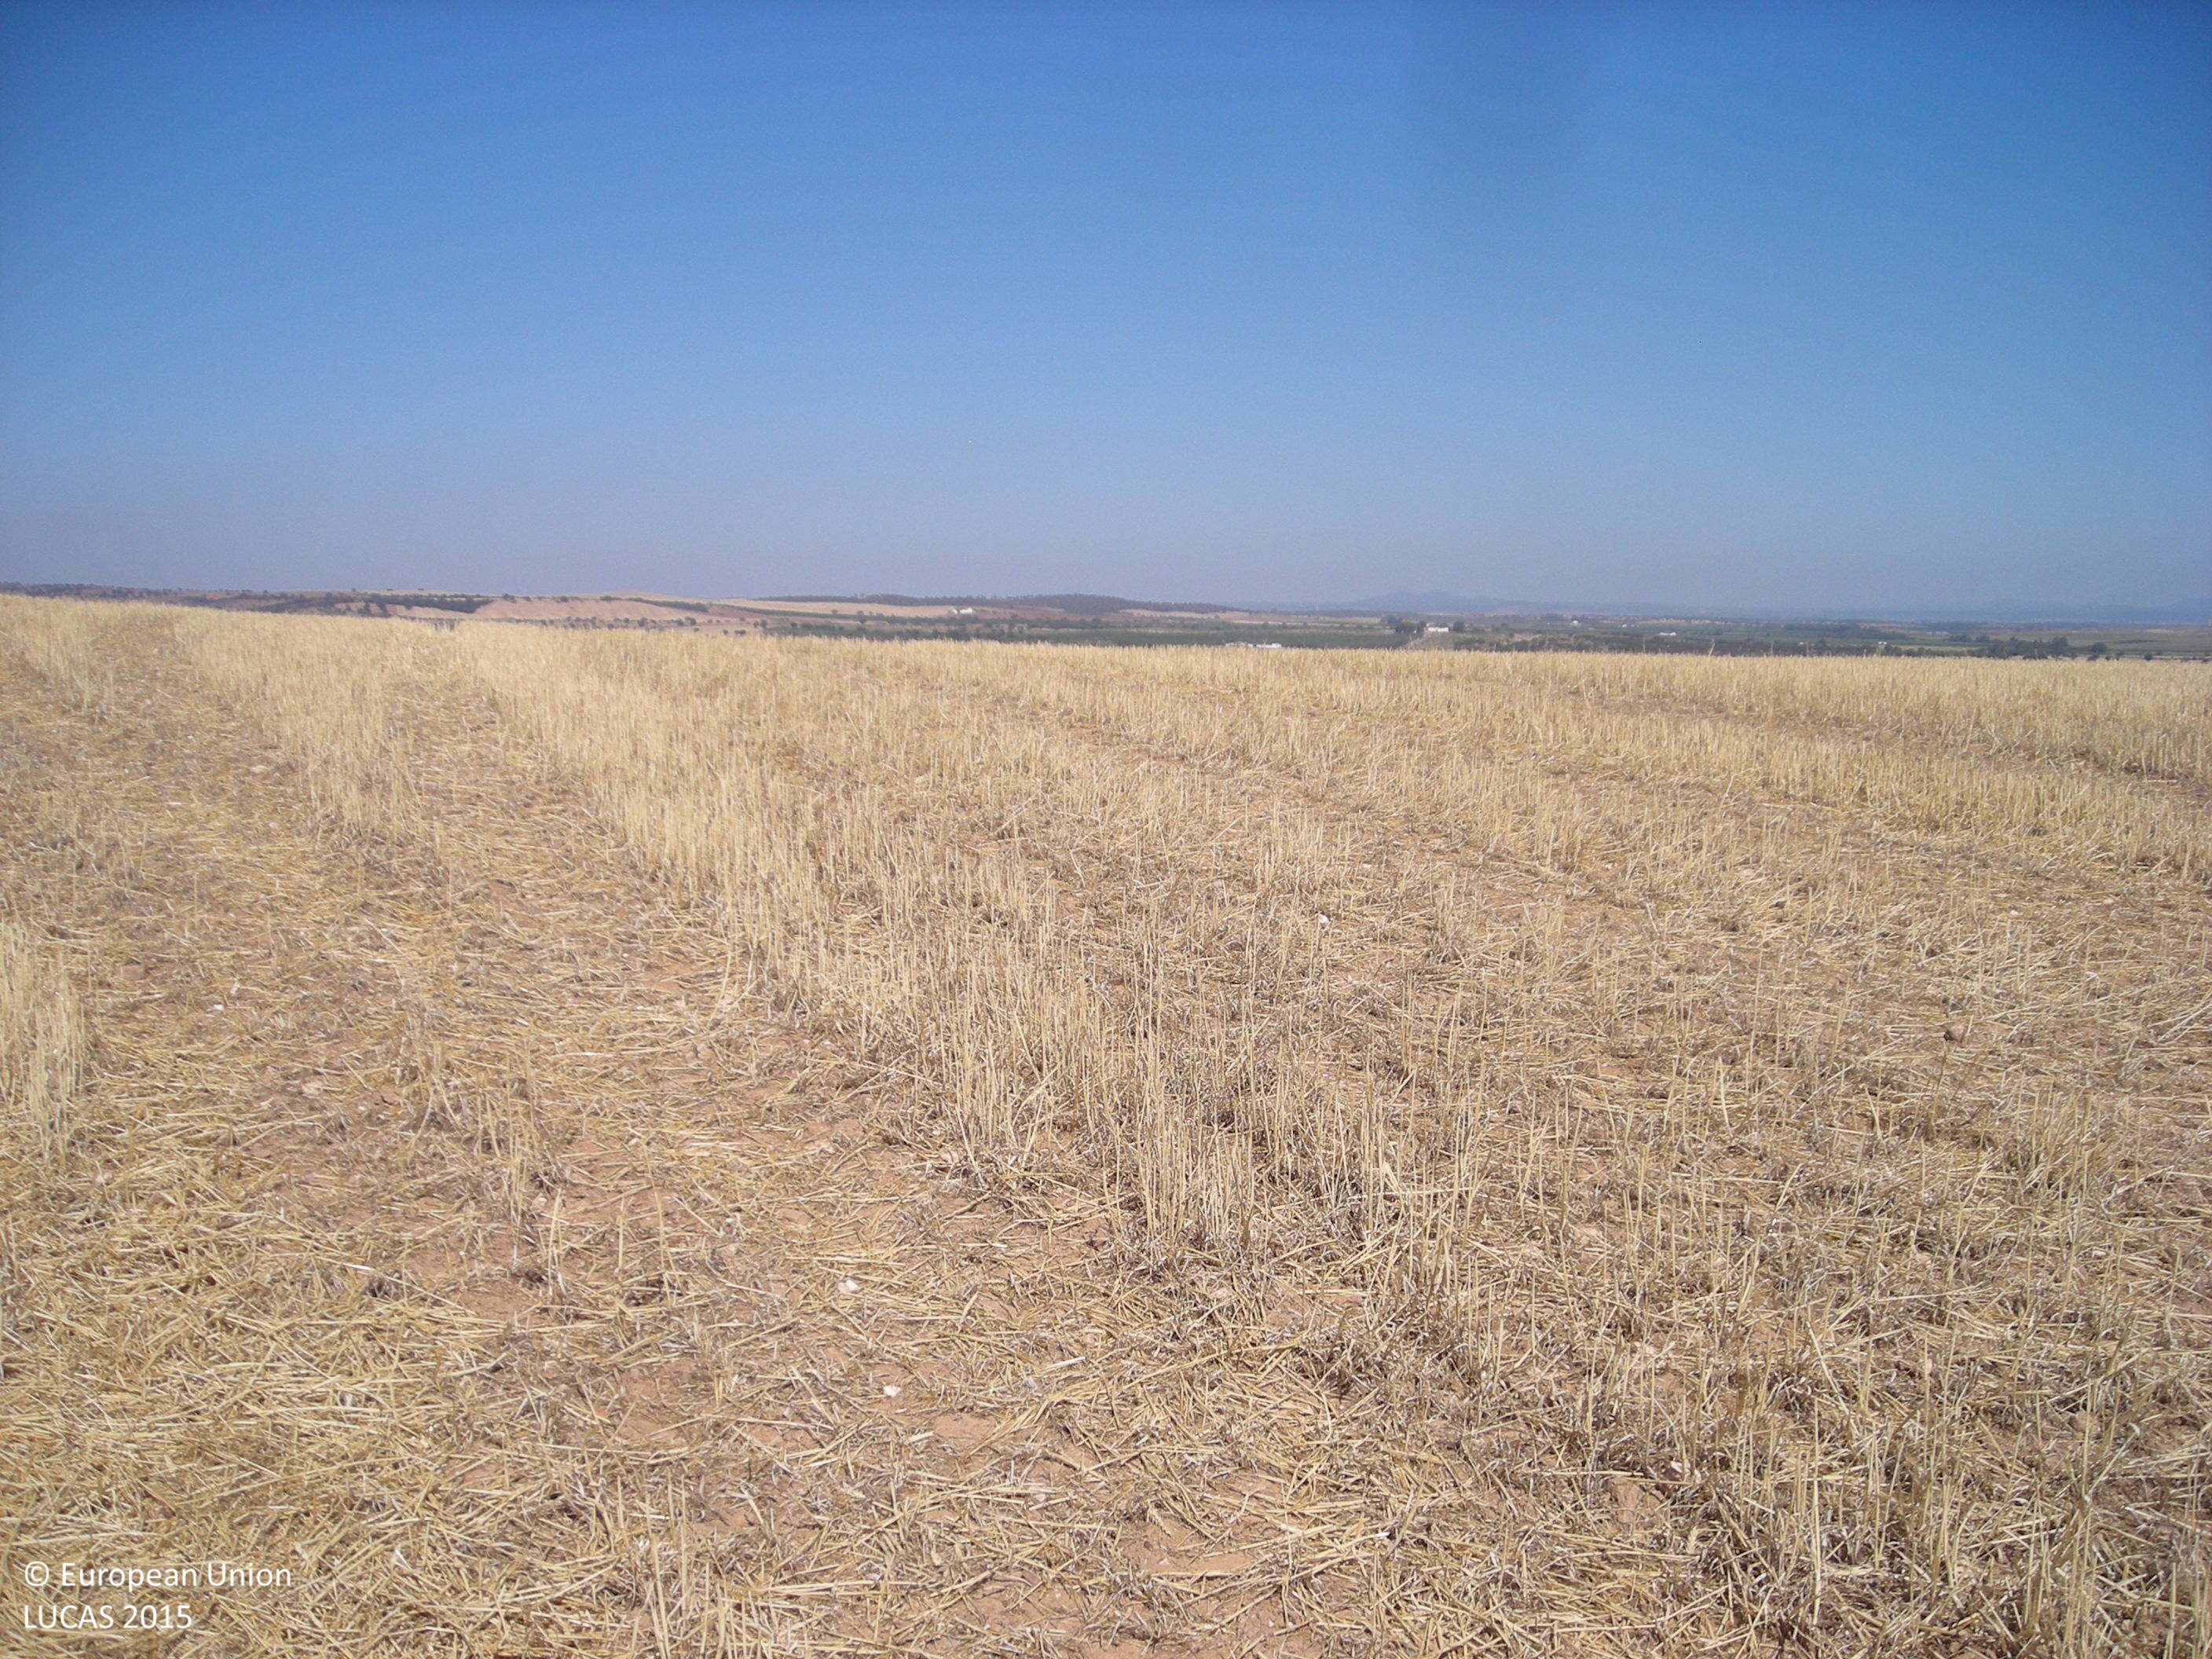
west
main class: Cropland
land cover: Common wheat
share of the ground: > 75 %
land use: Agriculture (excluding fallow land and kitchen gardens)
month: July
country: ES
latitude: 38.8308
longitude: -5.9102
